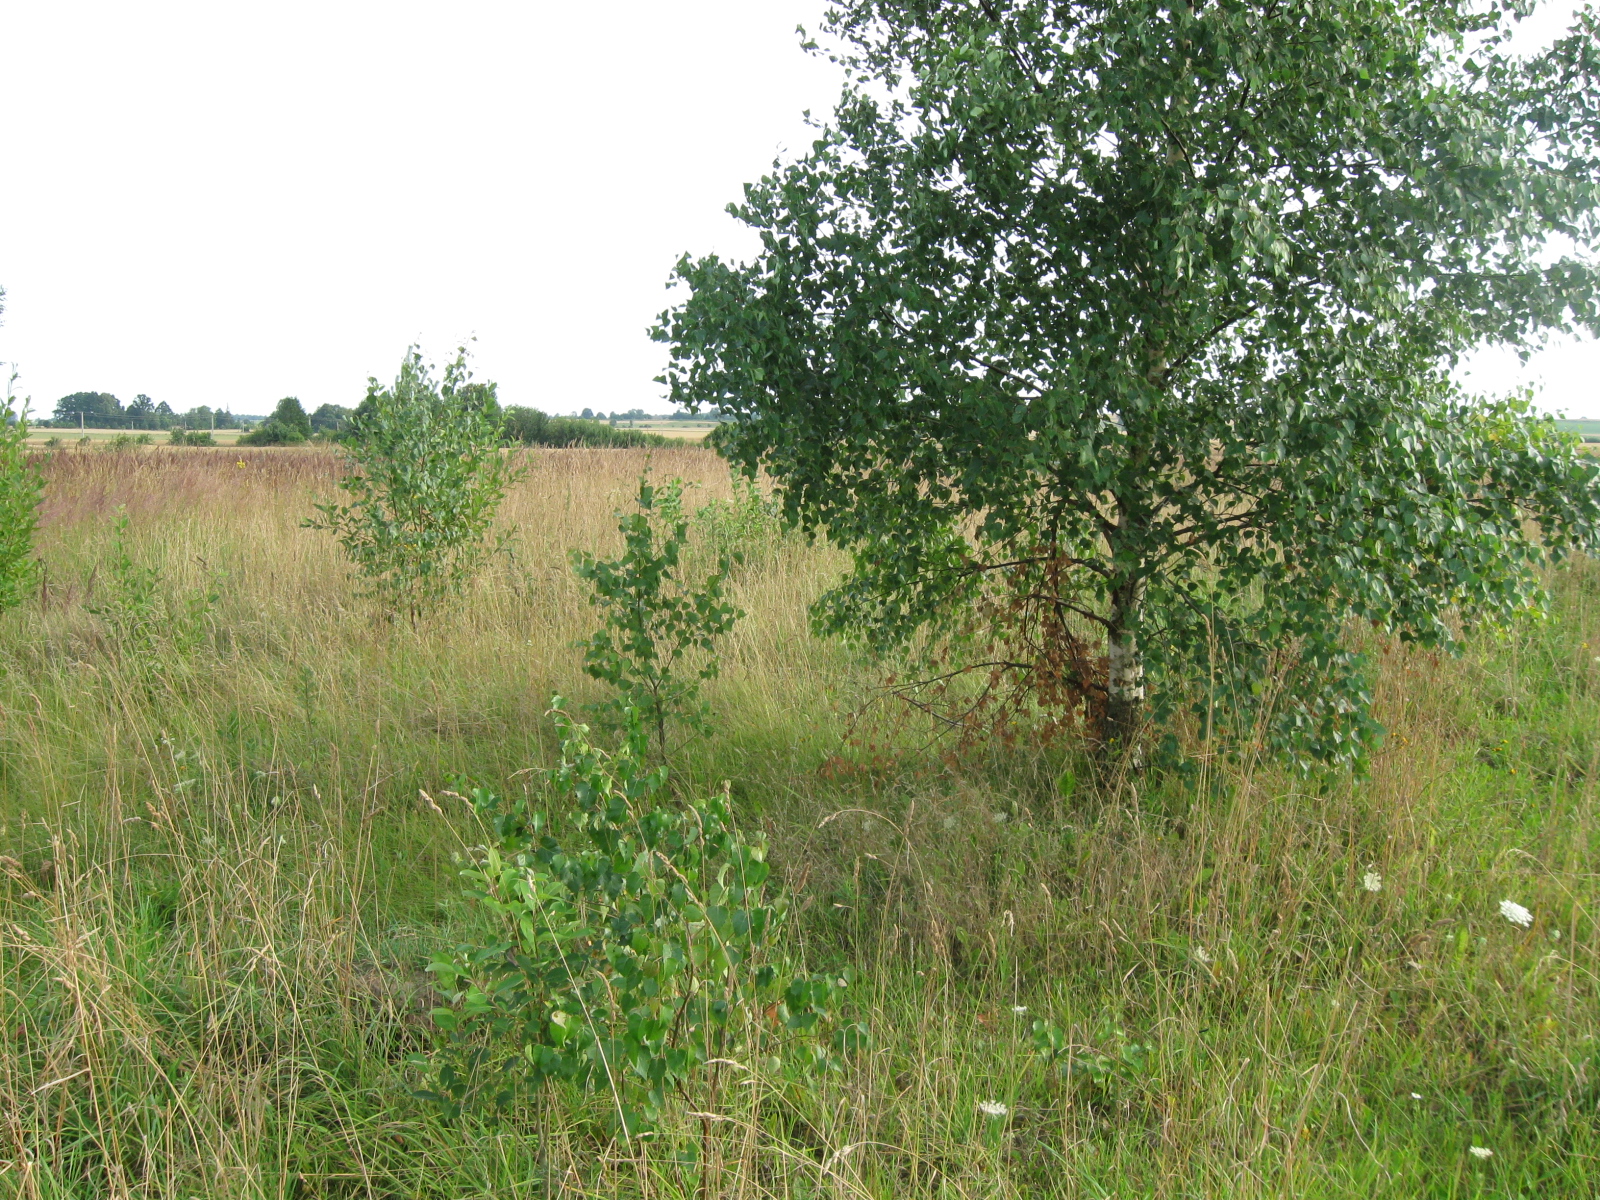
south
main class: Grassland
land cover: Grassland with sparse tree/shrub cover
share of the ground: > 75 %
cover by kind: herbaceous plants 90 %, broadleaved forest trees 5 %, shrubs 5 %
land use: Agriculture (excluding fallow land and kitchen gardens)
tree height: < 5 m
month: July
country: LT
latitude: 54.6864
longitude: 23.8160
